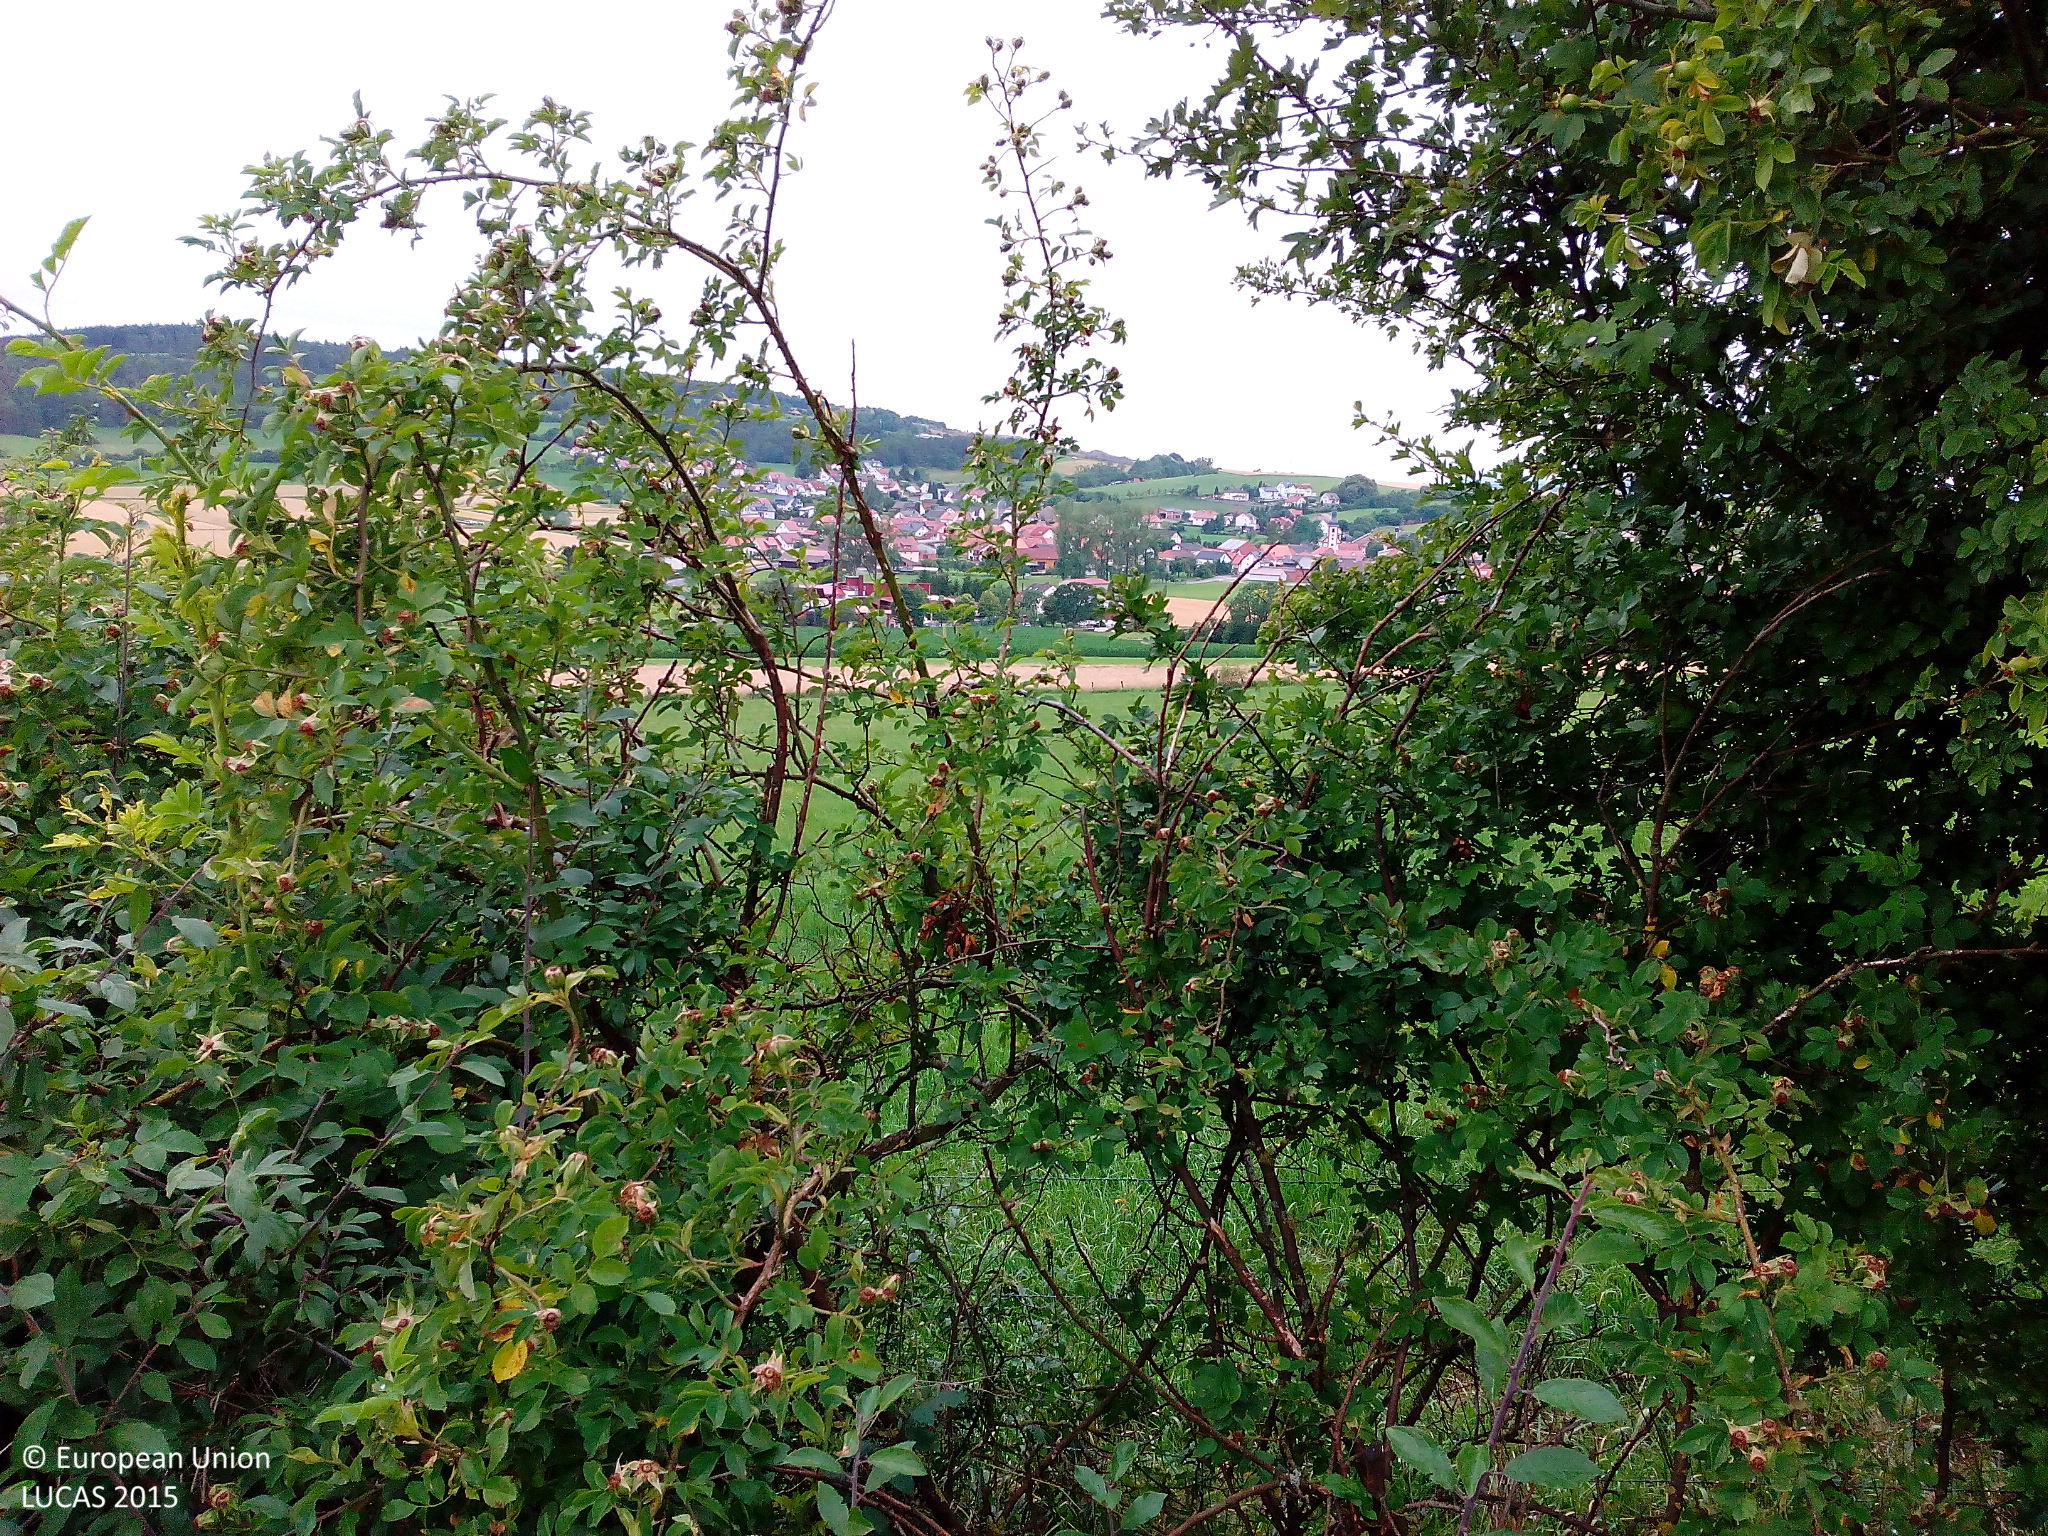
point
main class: Grassland
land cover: Grassland without tree/shrub cover
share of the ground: > 75 %
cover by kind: herbaceous plants 100 %
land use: Agriculture (excluding fallow land and kitchen gardens)
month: July
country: DE
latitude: 50.7775
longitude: 9.8724
